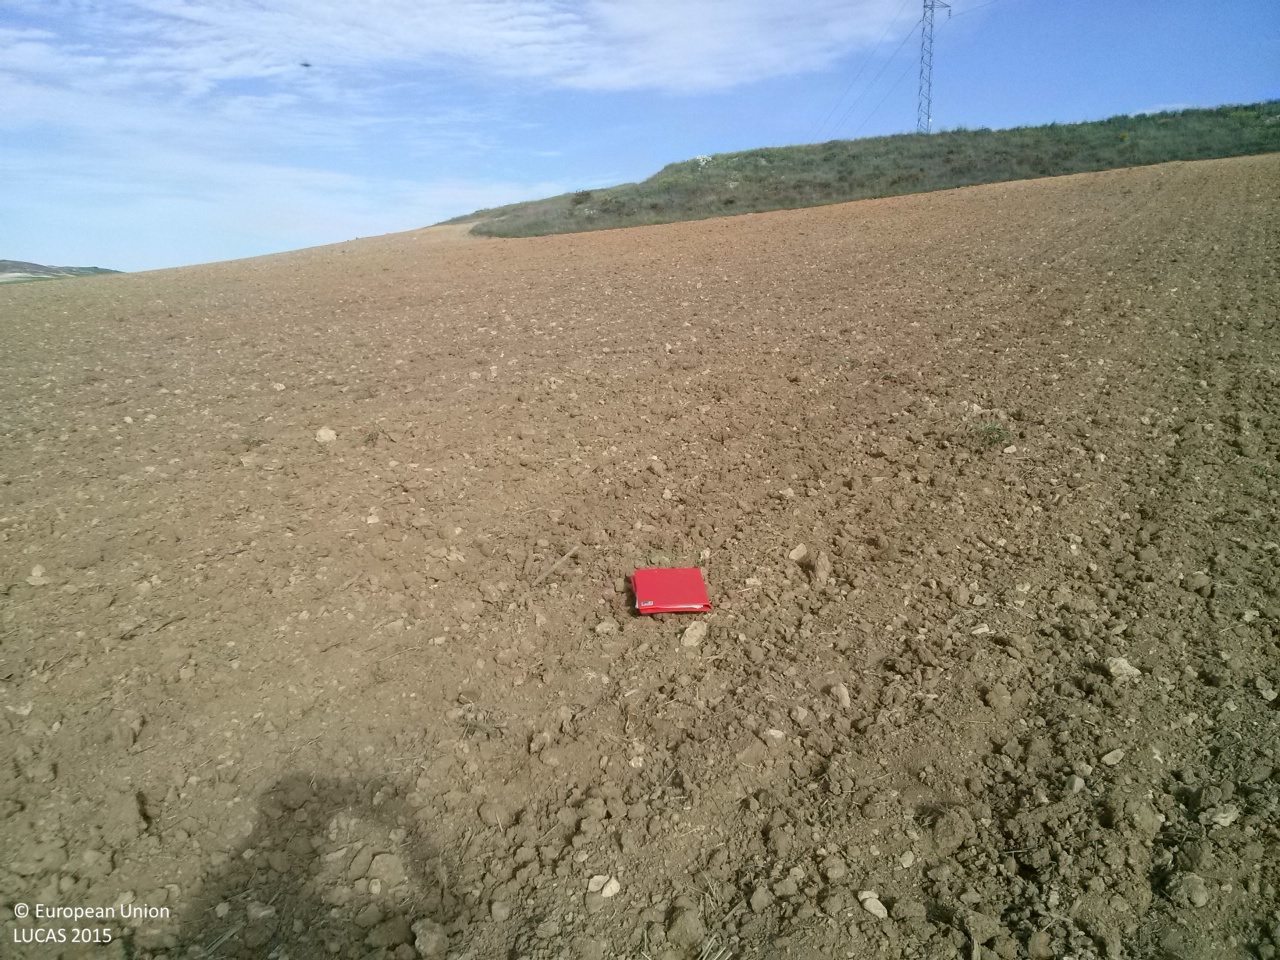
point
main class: Cropland
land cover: Sunflower
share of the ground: < 10 %
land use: Agriculture (excluding fallow land and kitchen gardens)
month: May
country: ES
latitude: 39.8915
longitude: -2.7316
